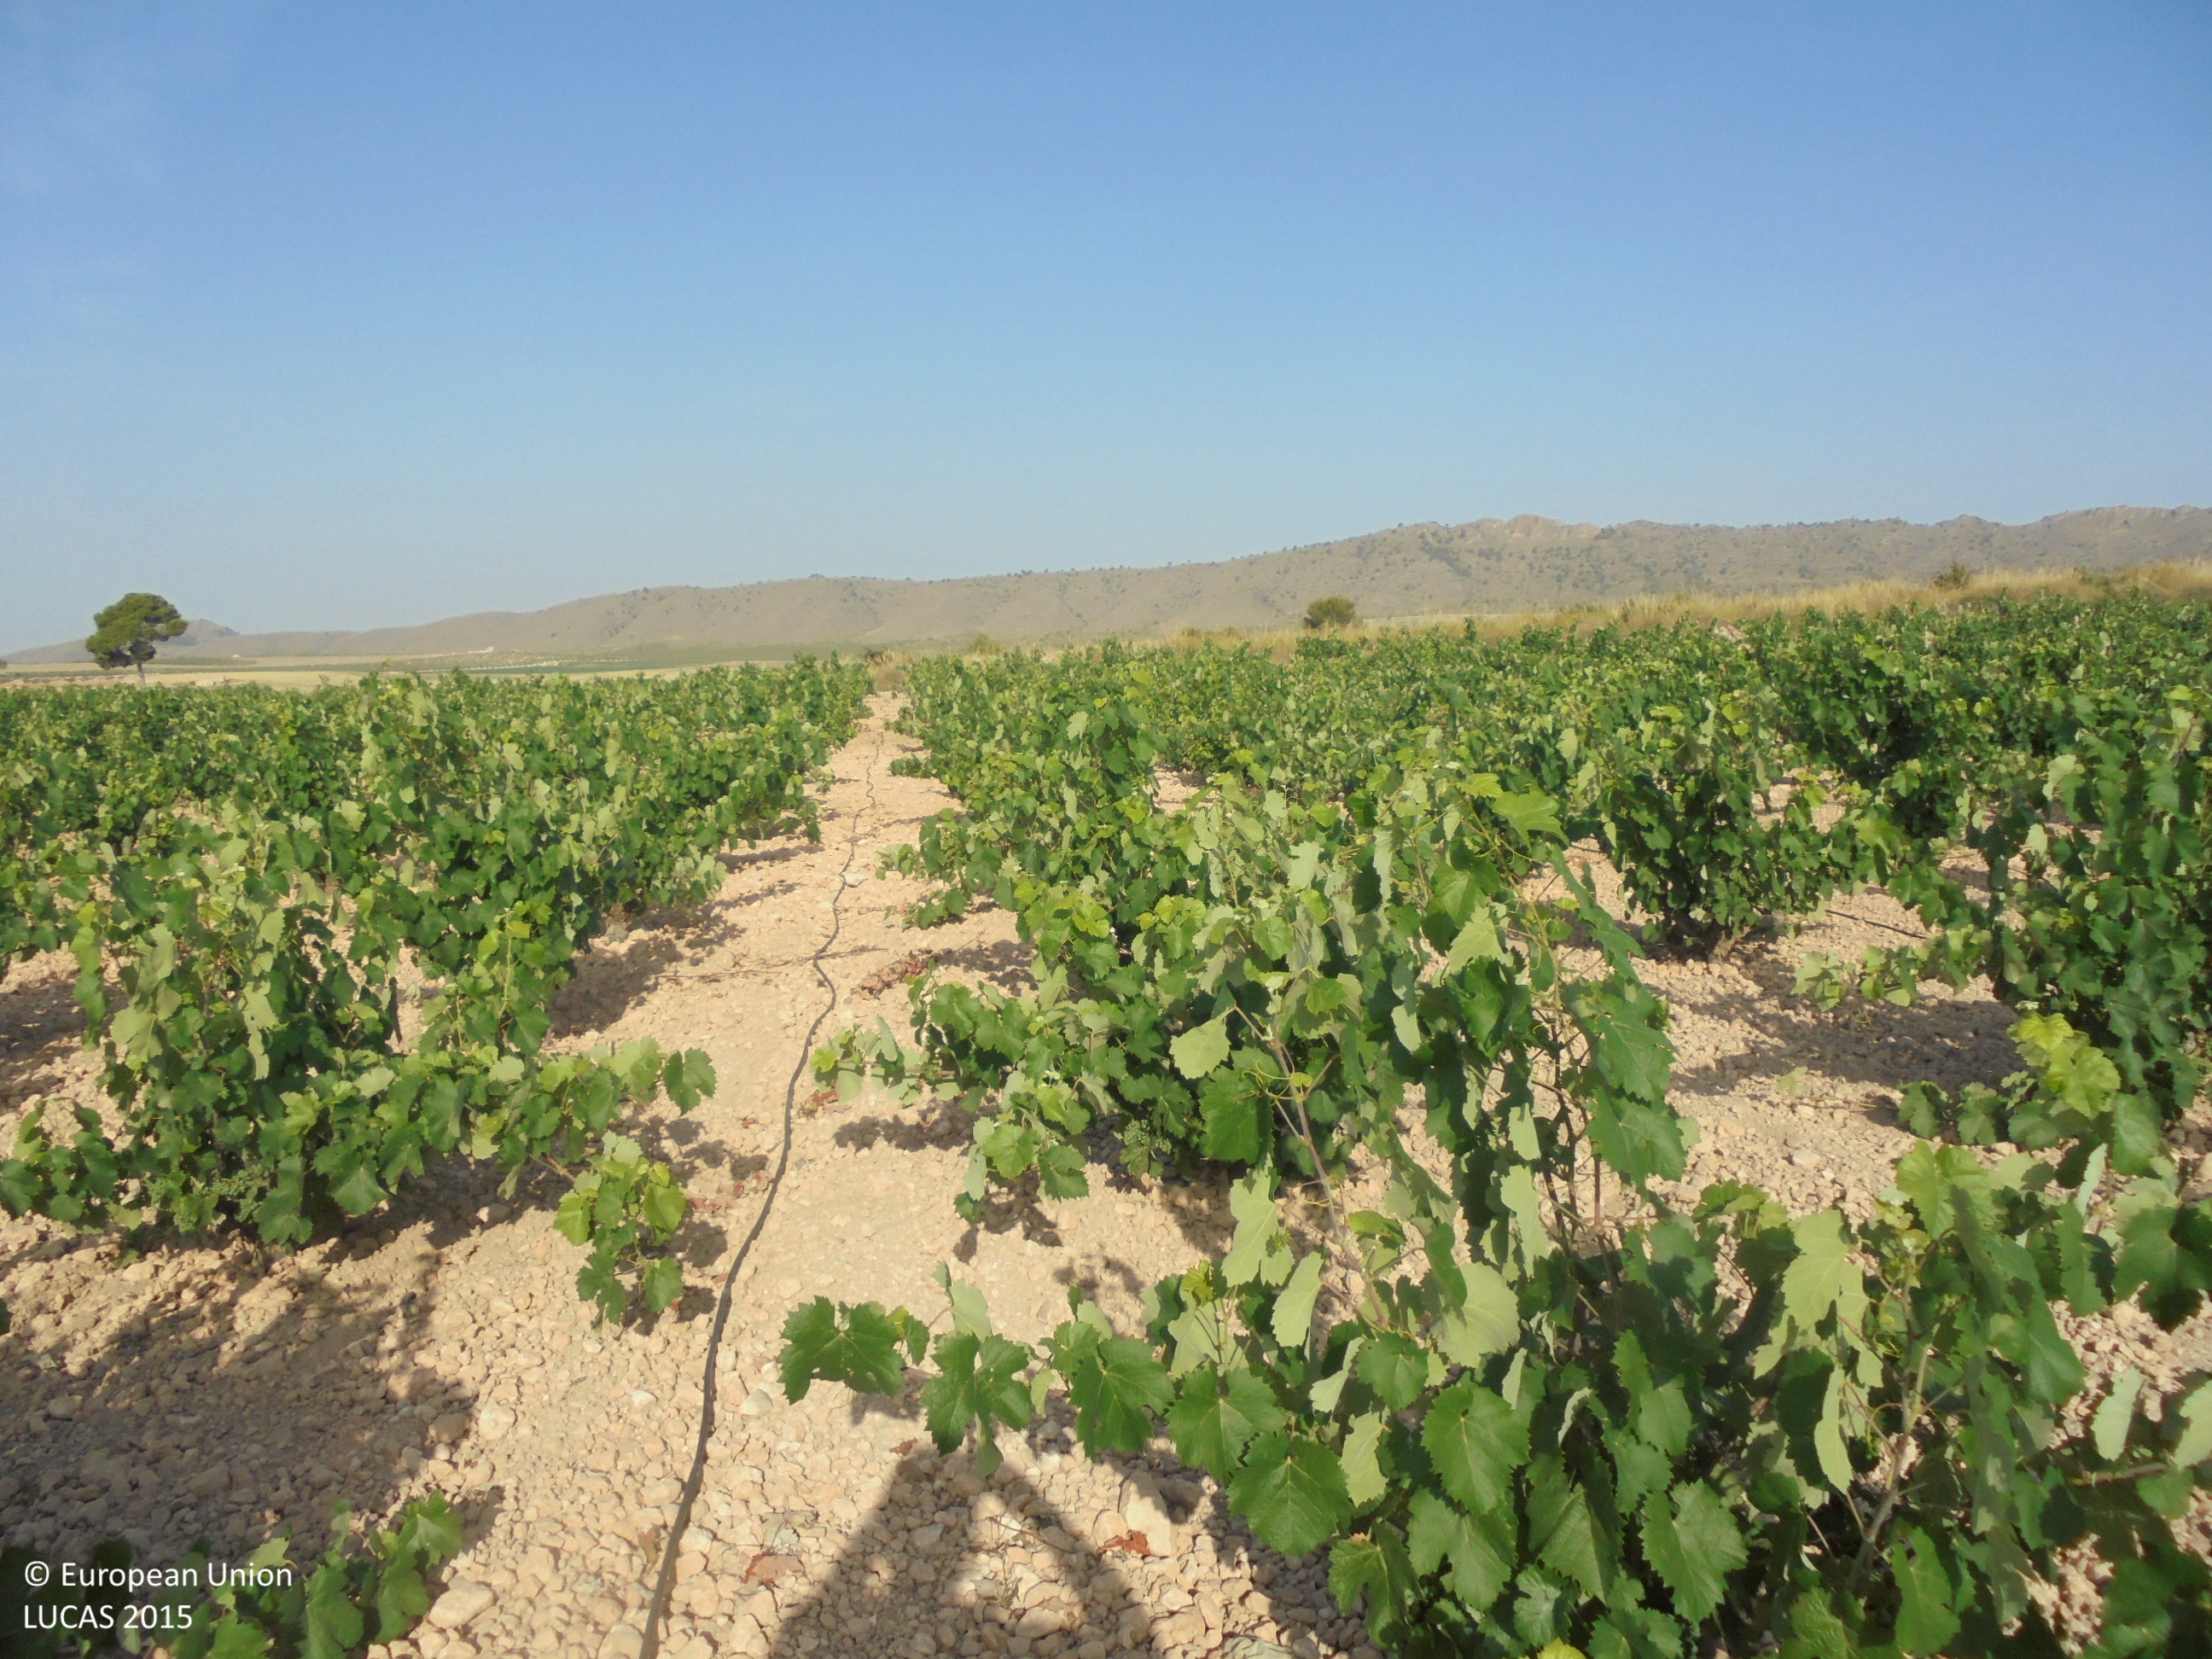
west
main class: Cropland
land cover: Vineyards
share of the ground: 25 - 50 %
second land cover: Other bare soil
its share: > 75 %
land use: Agriculture (excluding fallow land and kitchen gardens)
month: July
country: ES
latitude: 38.6437
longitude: -1.6101
